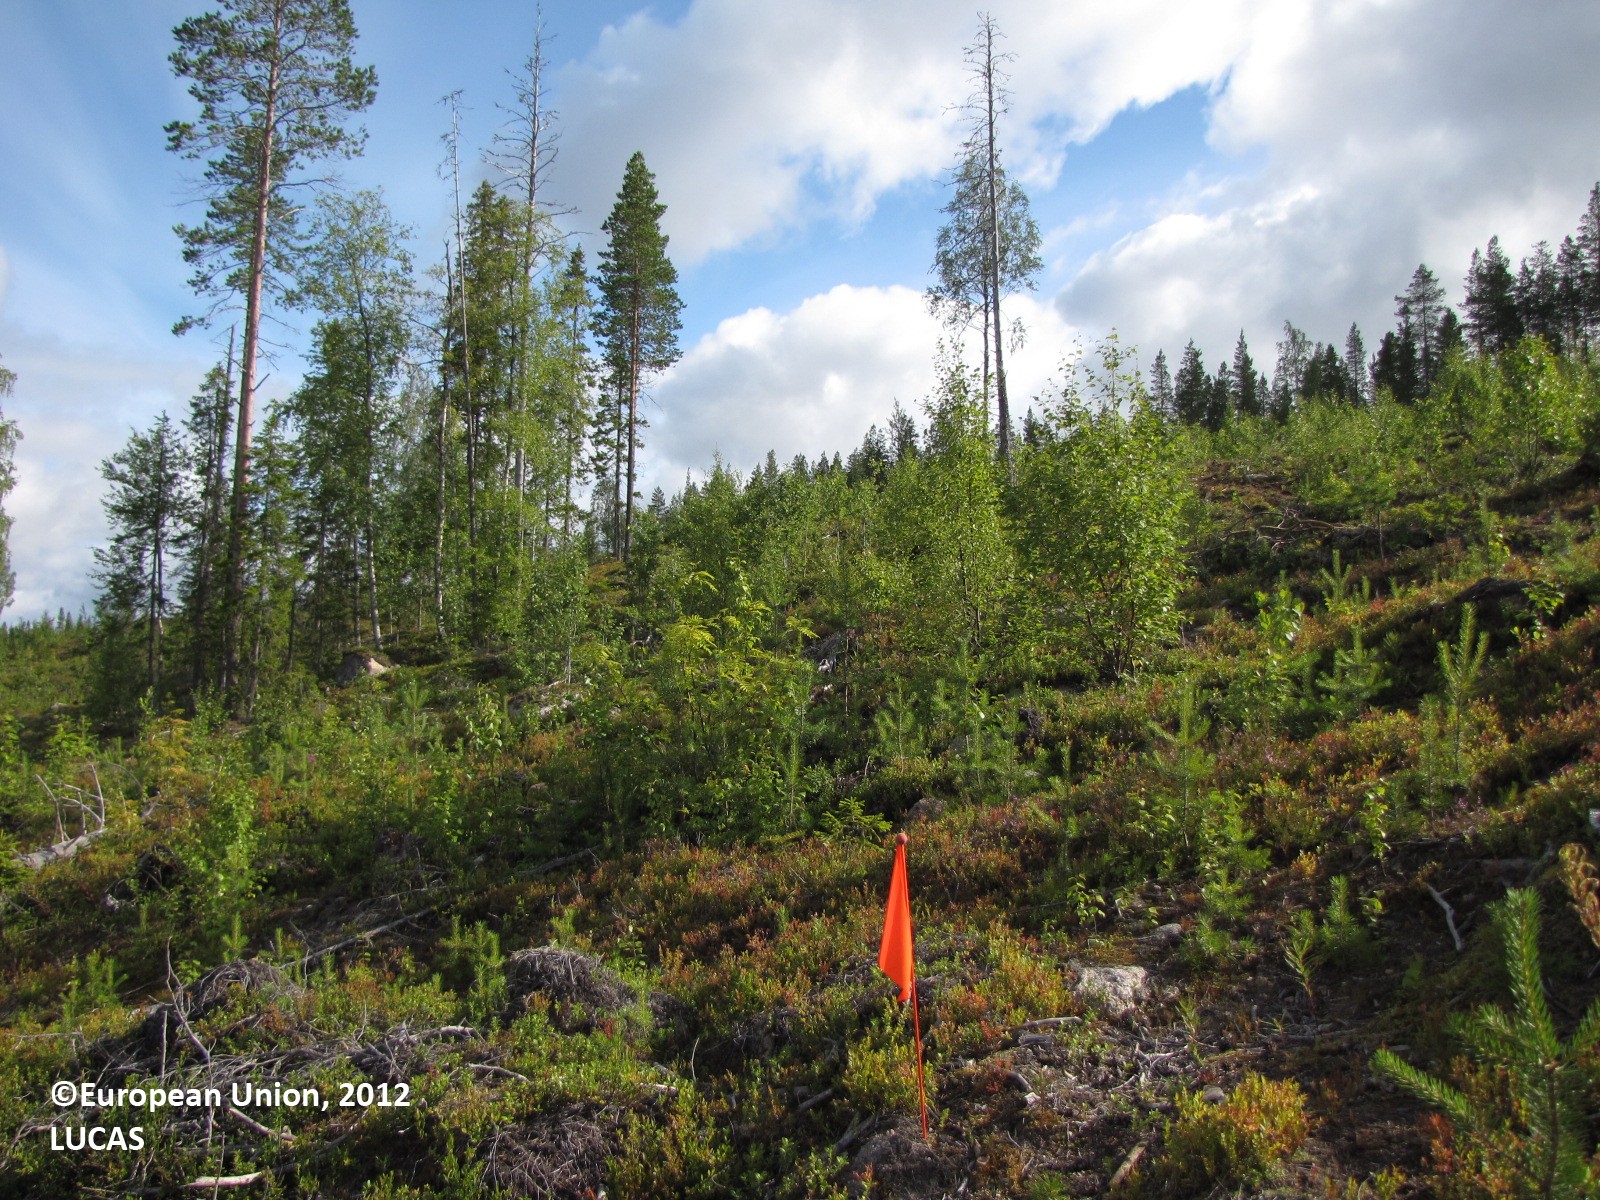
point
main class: Woodland
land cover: Pine dominated mixed woodland
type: boreal forest
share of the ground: 10 - 25 %
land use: Forestry
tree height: < 5 m
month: August
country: FI
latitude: 66.8699
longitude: 24.6655
